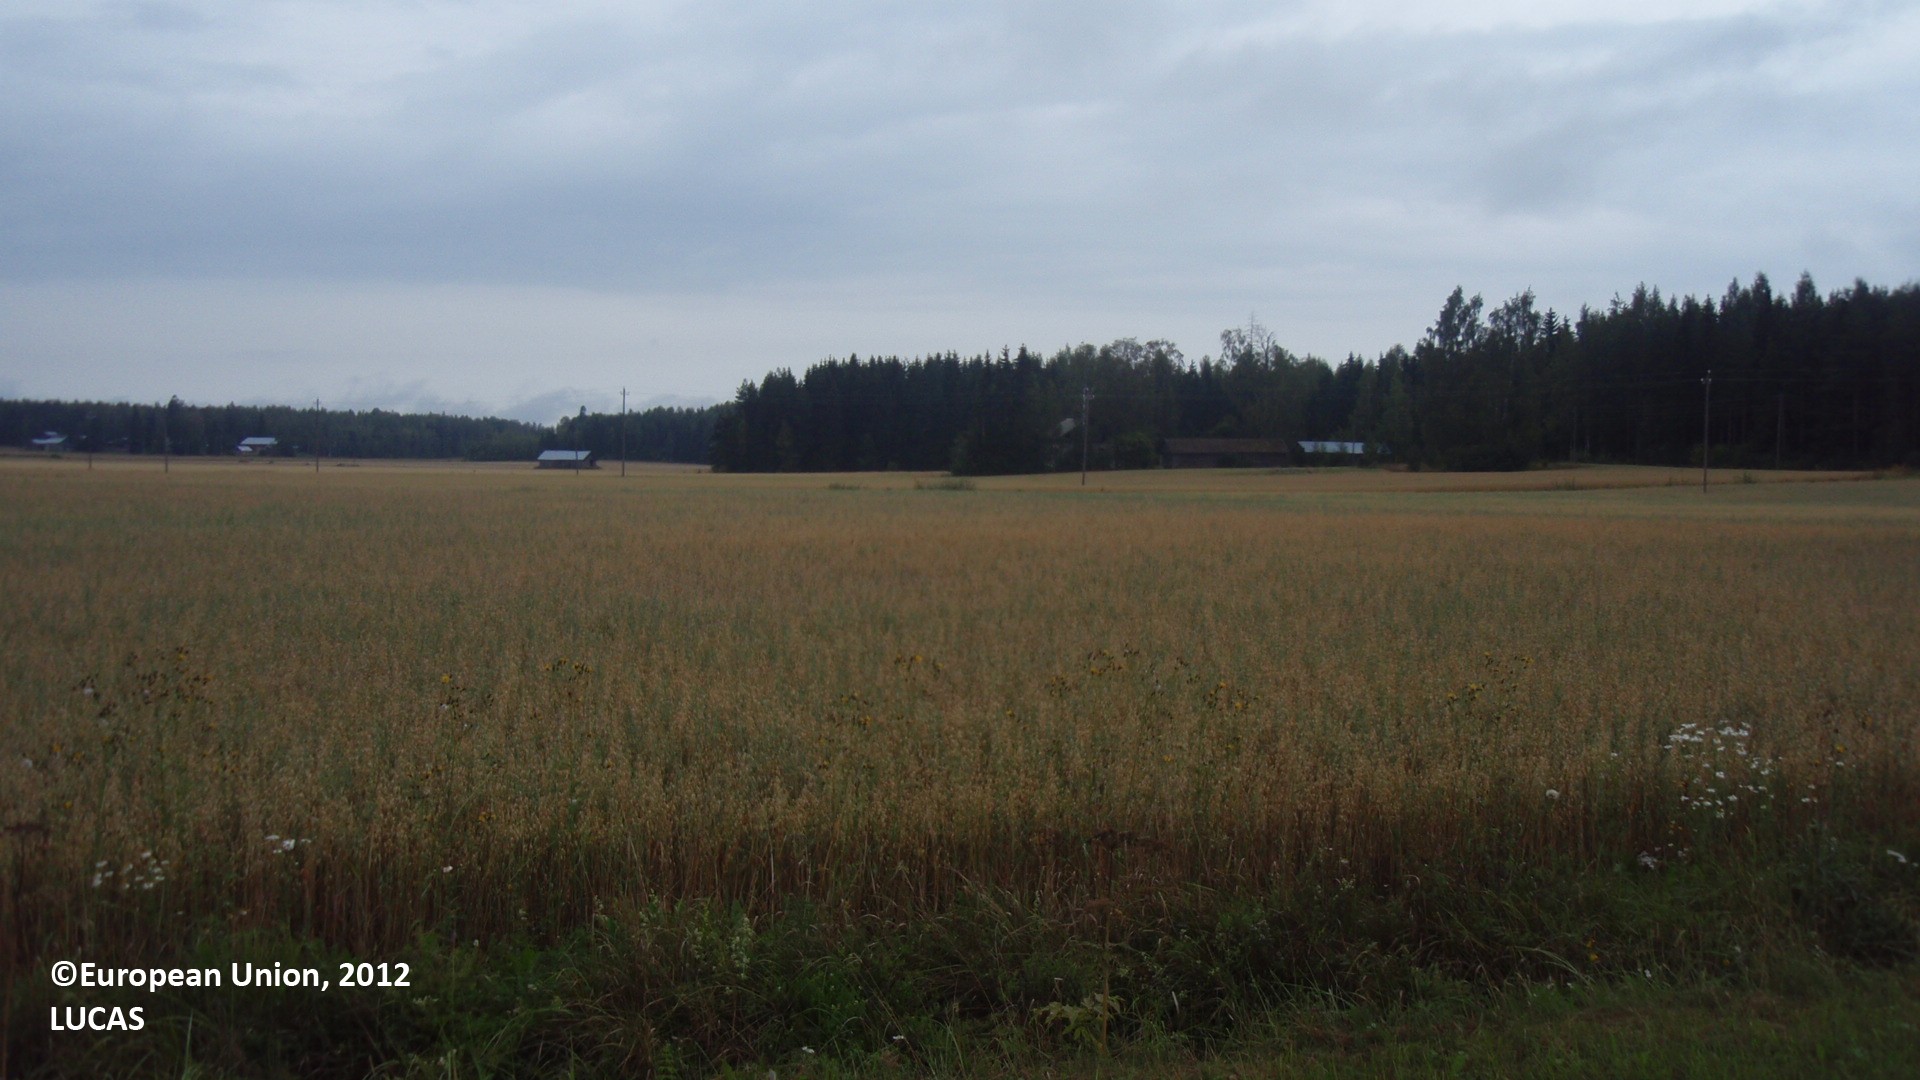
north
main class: Cropland
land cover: Oats
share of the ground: > 75 %
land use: Agriculture (excluding fallow land and kitchen gardens)
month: August
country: FI
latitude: 60.7375
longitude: 26.9103
